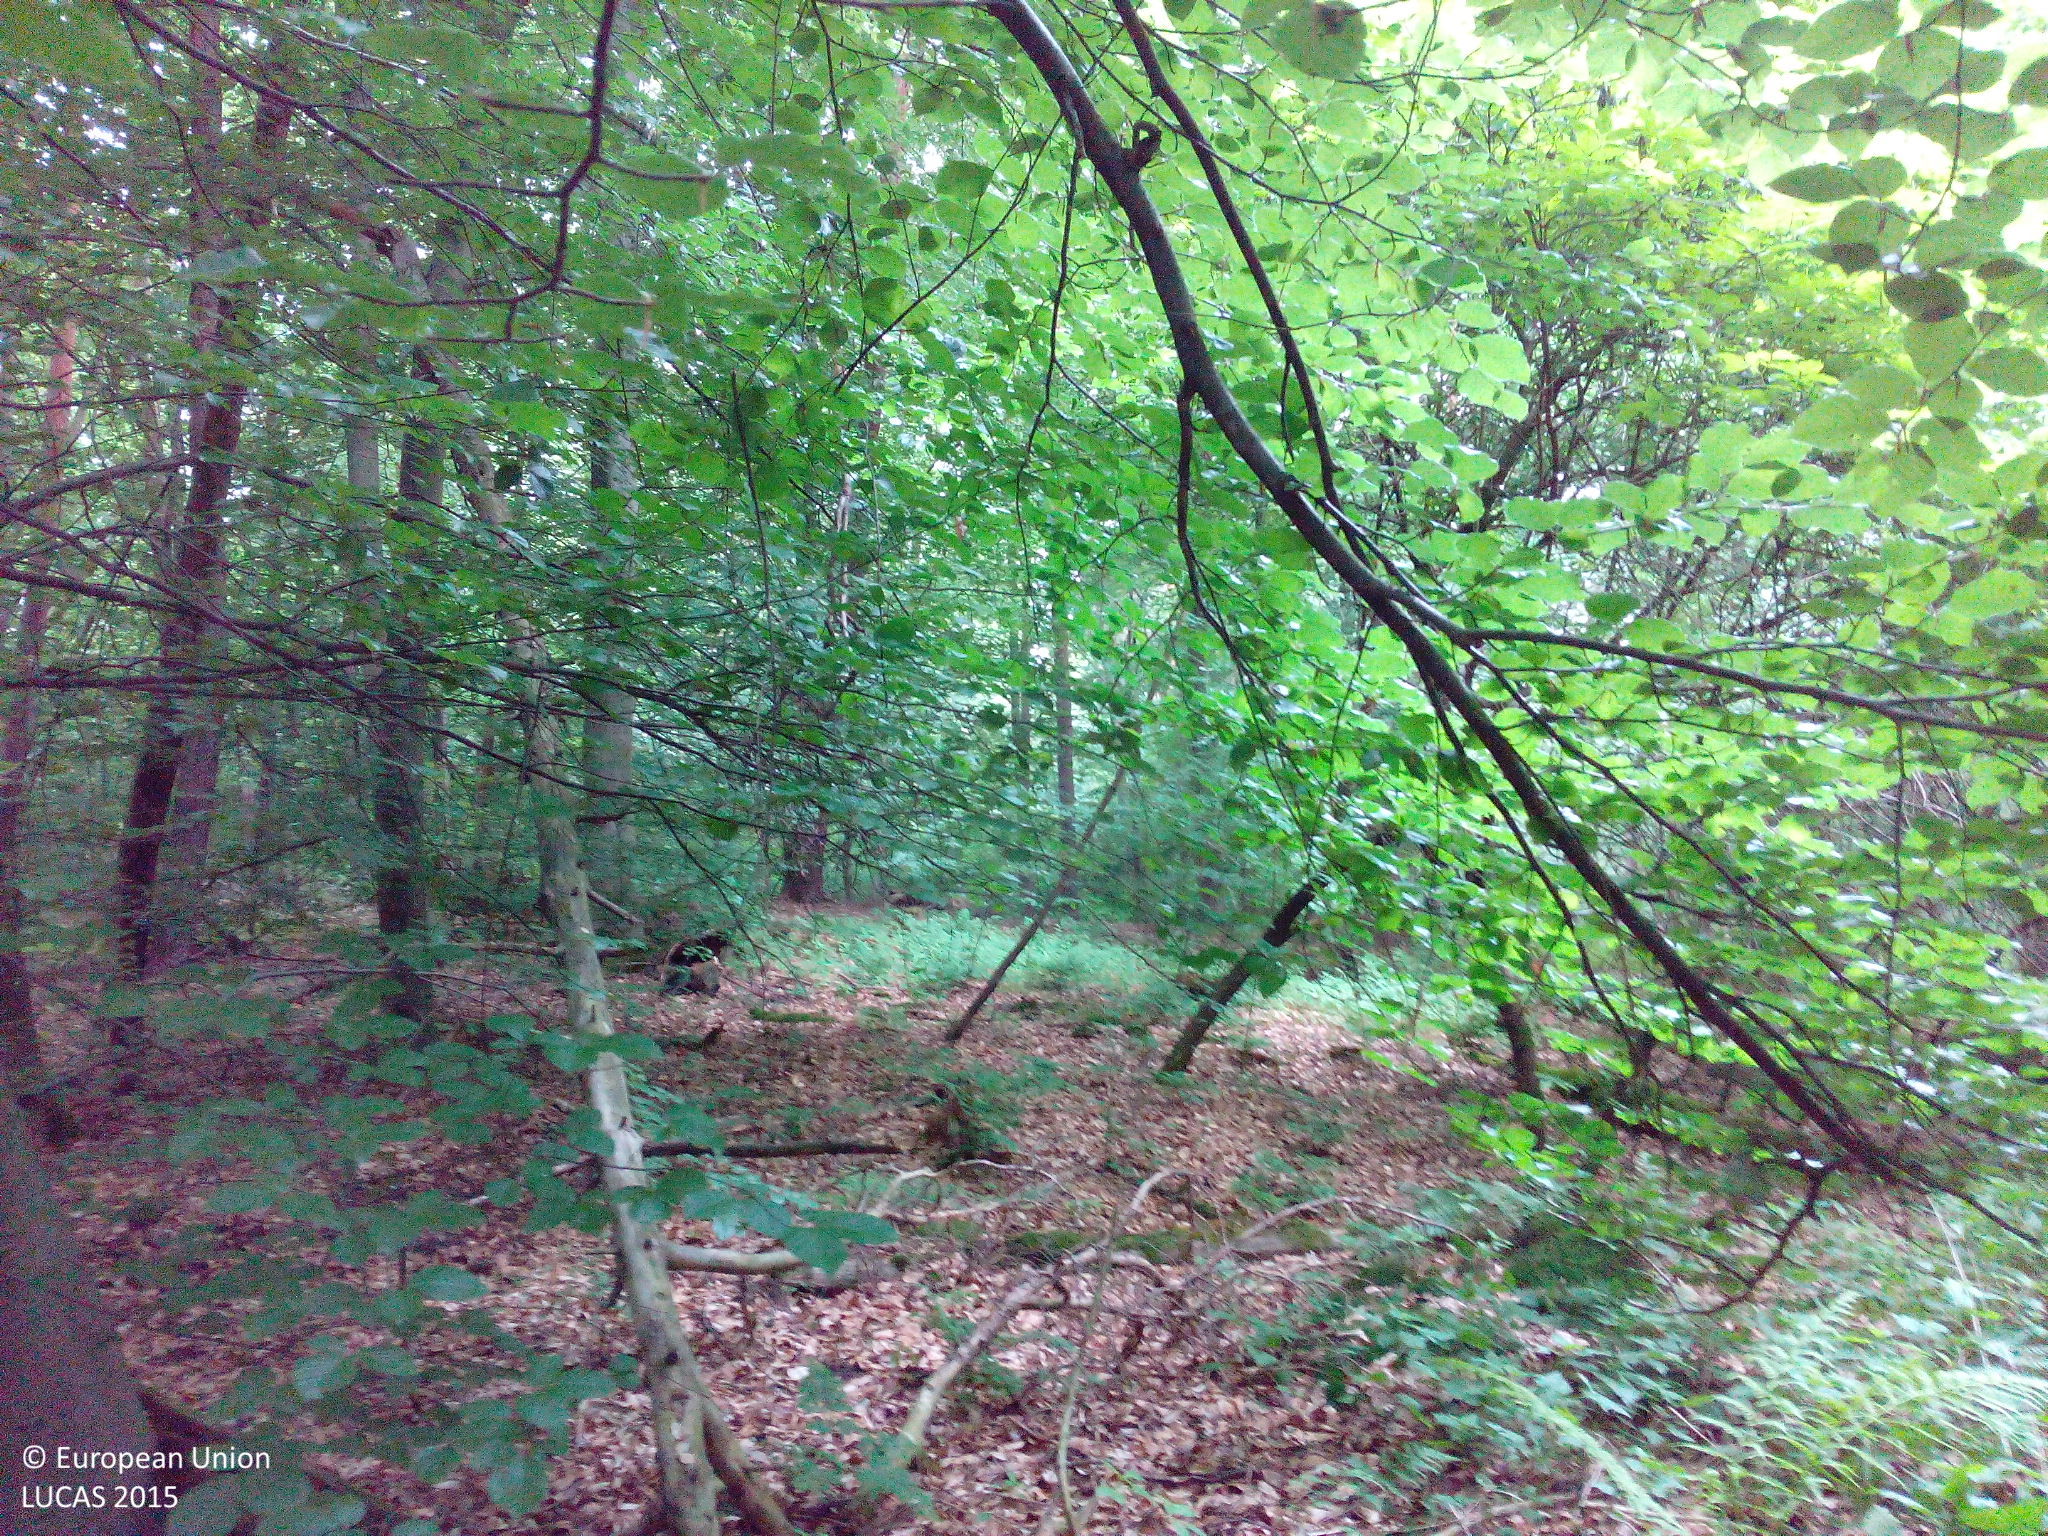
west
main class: Woodland
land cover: Broadleaved woodland
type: beech forest
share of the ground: > 75 %
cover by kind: broadleaved forest trees 85 %, coniferous forest trees 5 %, herbaceous plants 5 %, unconsolidated bare surface 5 %
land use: Forestry
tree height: > 5 m
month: May
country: DE
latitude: 48.7837
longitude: 8.1361
